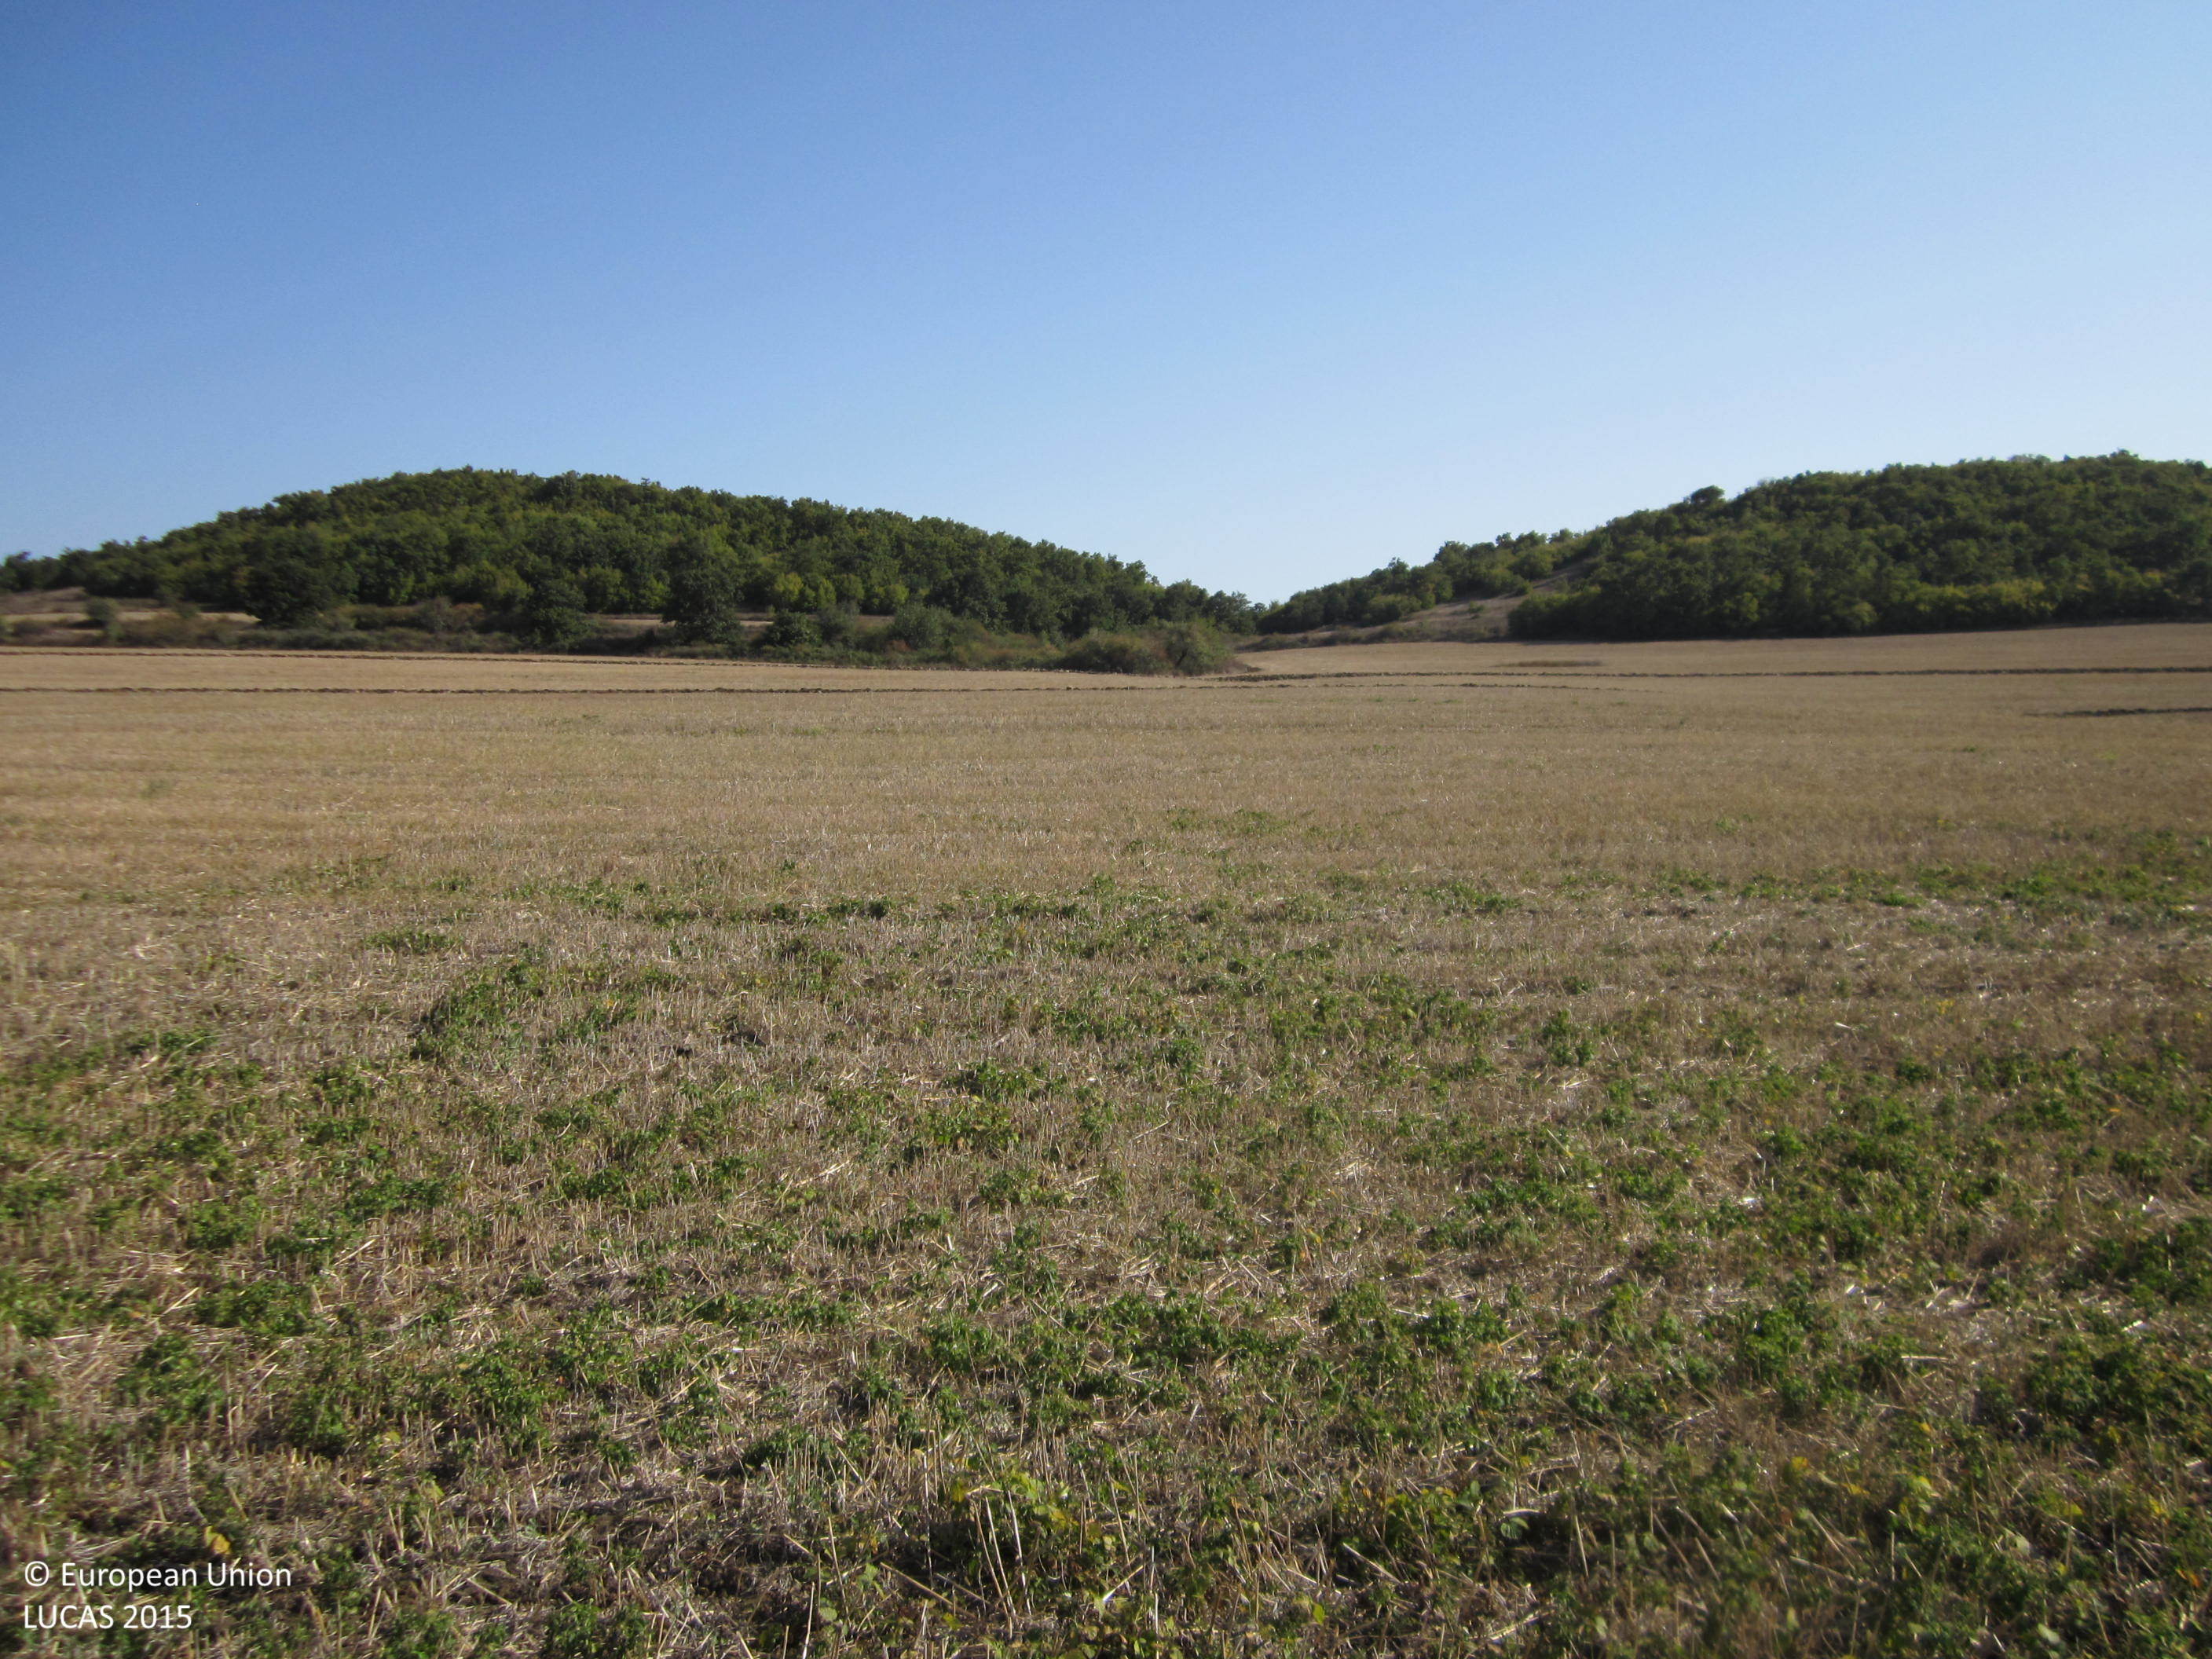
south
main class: Cropland
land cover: Common wheat
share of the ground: 25 - 50 %
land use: Agriculture (excluding fallow land and kitchen gardens)
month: September
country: BG
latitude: 42.7063
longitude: 27.3680
